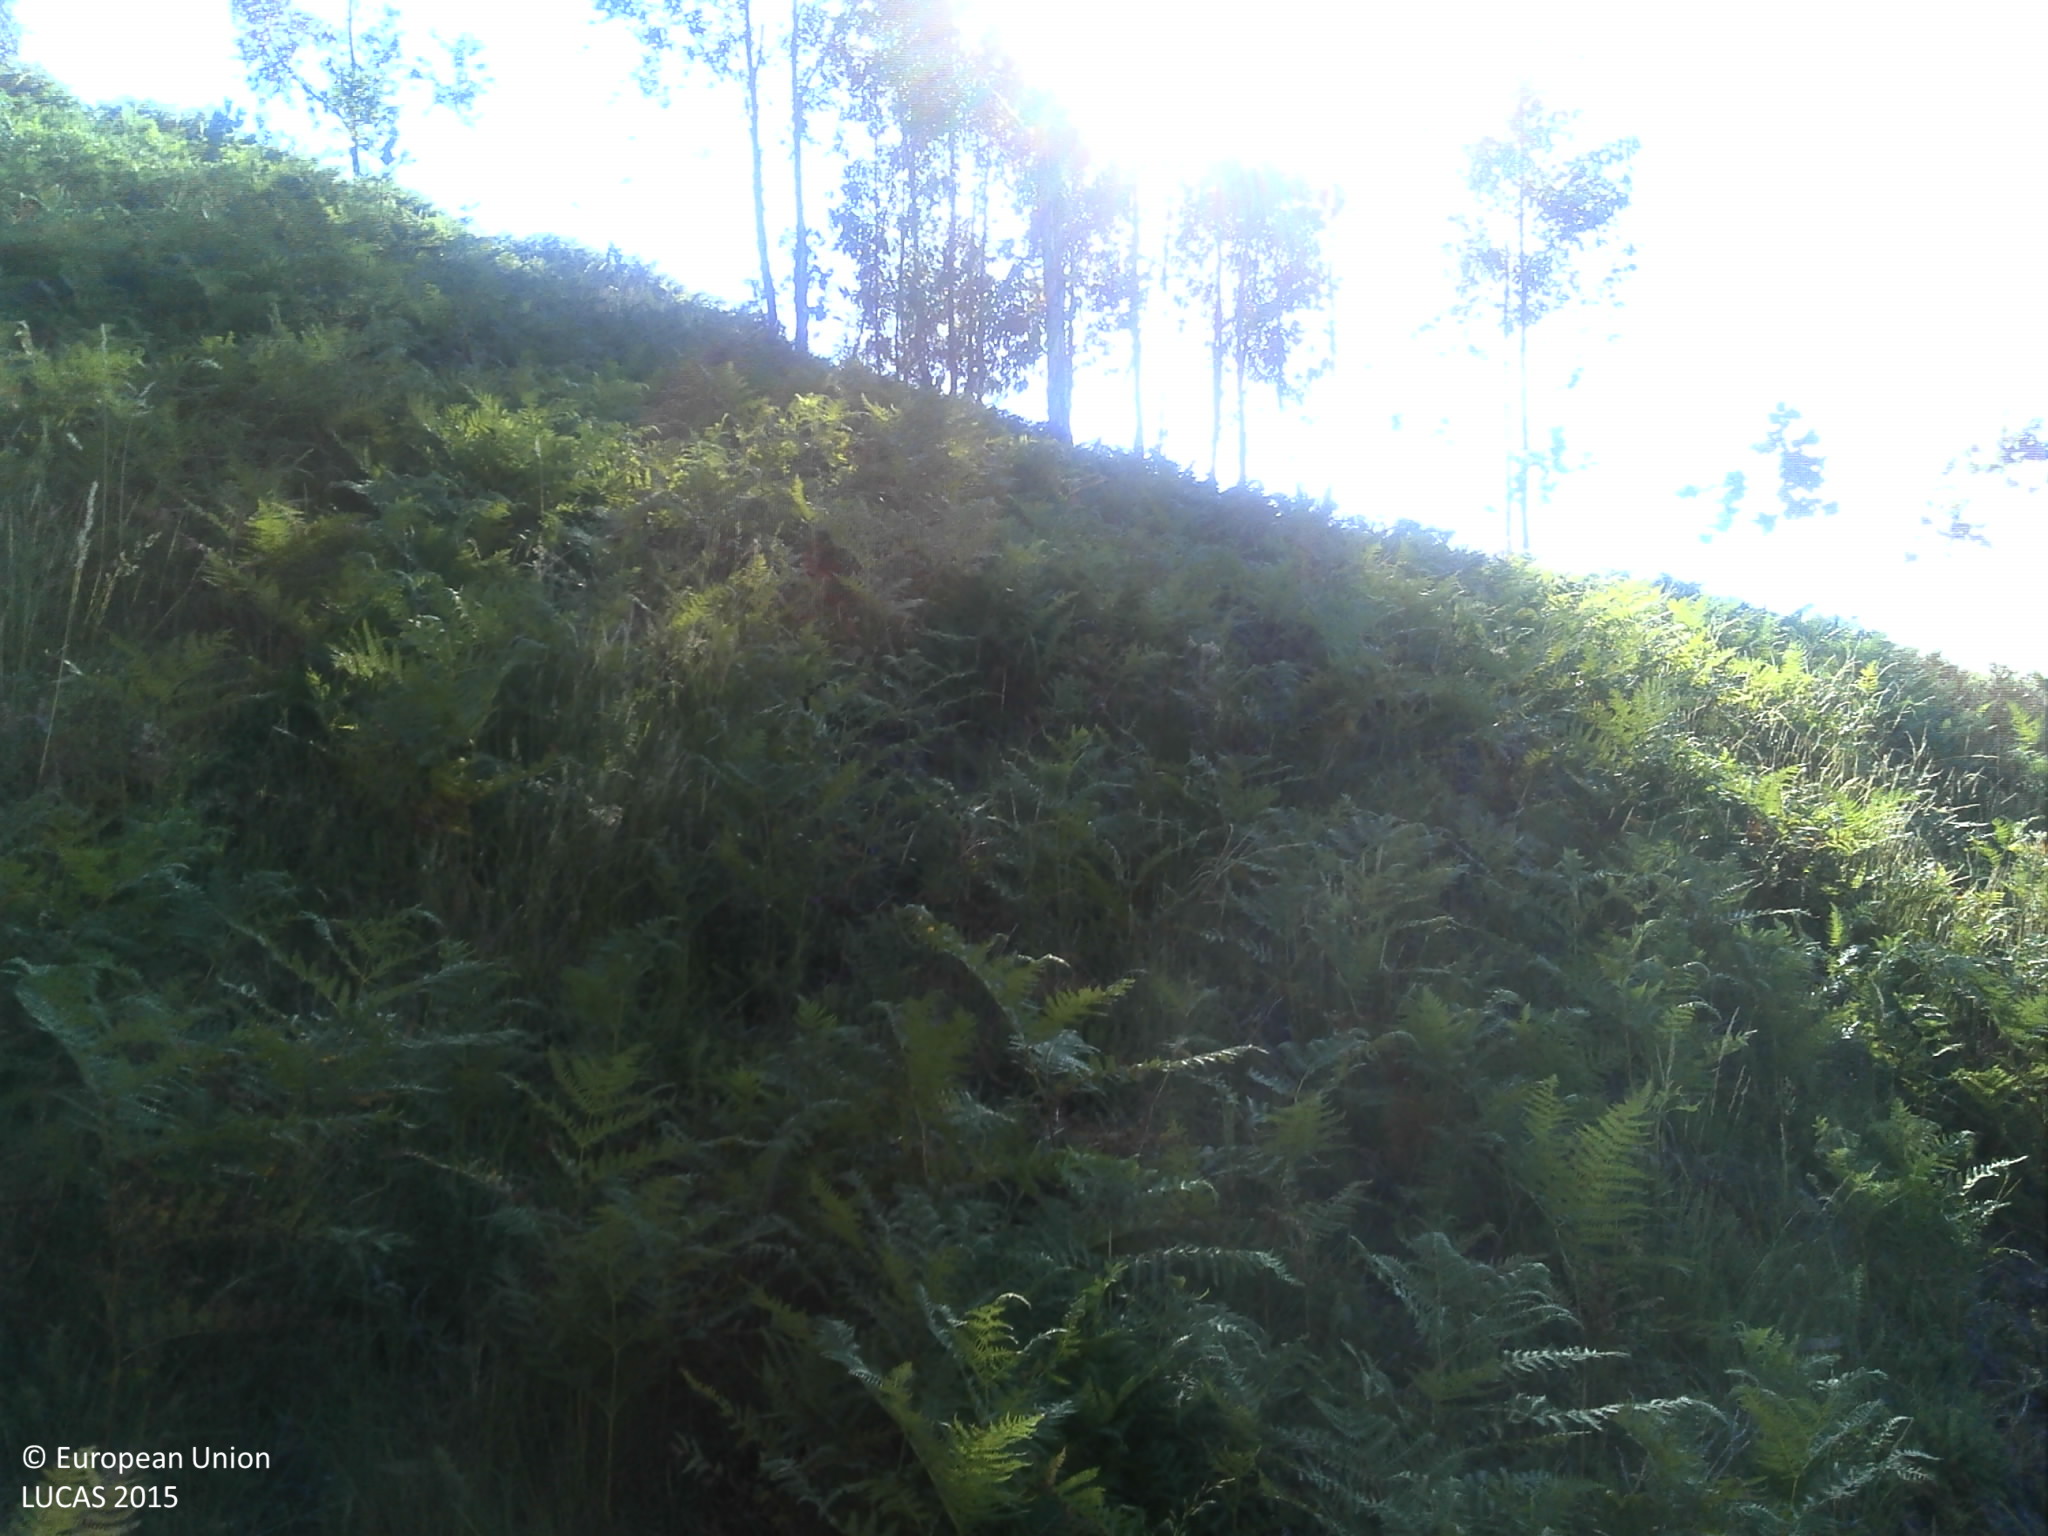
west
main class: Shrubland
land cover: Shrubland with sparse tree cover
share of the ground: > 75 %
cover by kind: shrubs 85 %, broadleaved forest trees 5 %, herbaceous plants 5 %, unconsolidated bare surface 5 %
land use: Agriculture (excluding fallow land and kitchen gardens)
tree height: < 5 m
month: June
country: PT
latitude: 41.5491
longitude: -8.1650
